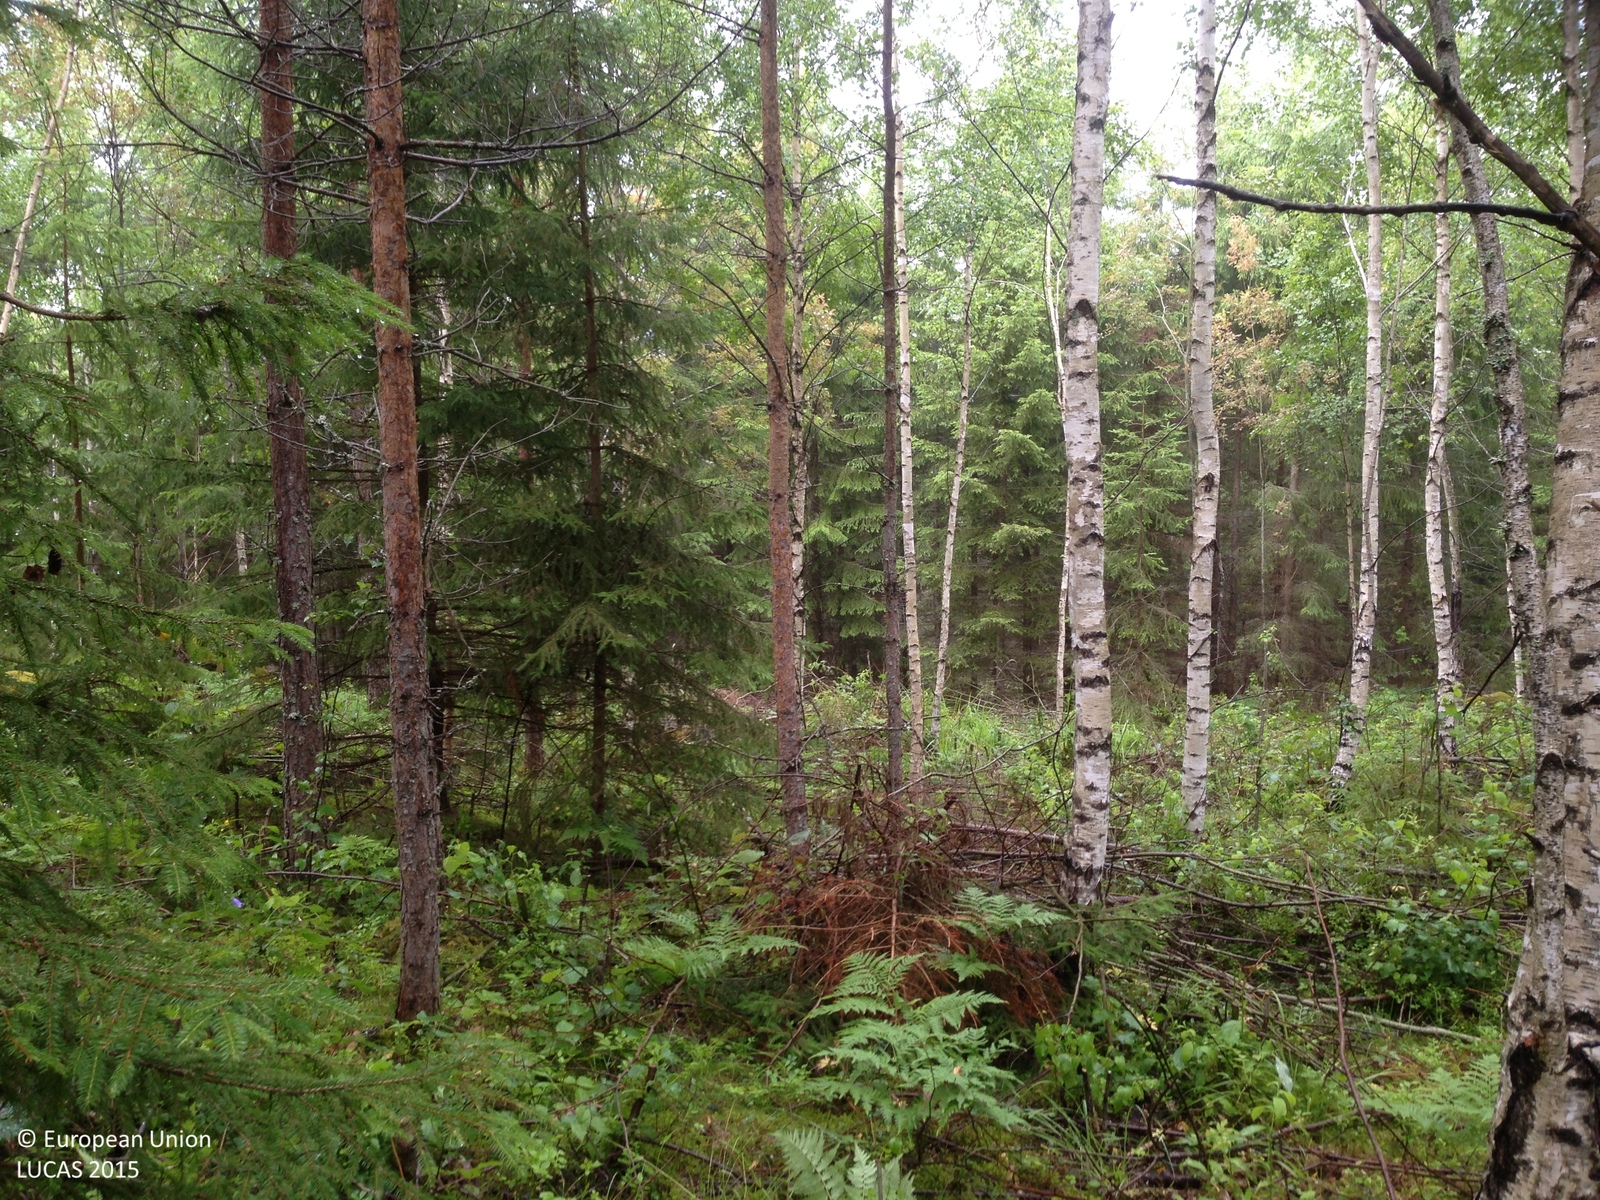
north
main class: Woodland
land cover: Spruce dominated mixed woodland
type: boreal forest
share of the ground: 50 - 75 %
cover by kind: coniferous forest trees 45 %, lichens and mosses 20 %, broadleaved forest trees 15 %, herbaceous plants 15 %, shrubs 5 %
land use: Forestry
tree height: > 5 m
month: July
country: SE
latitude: 59.8755
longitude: 18.6987
